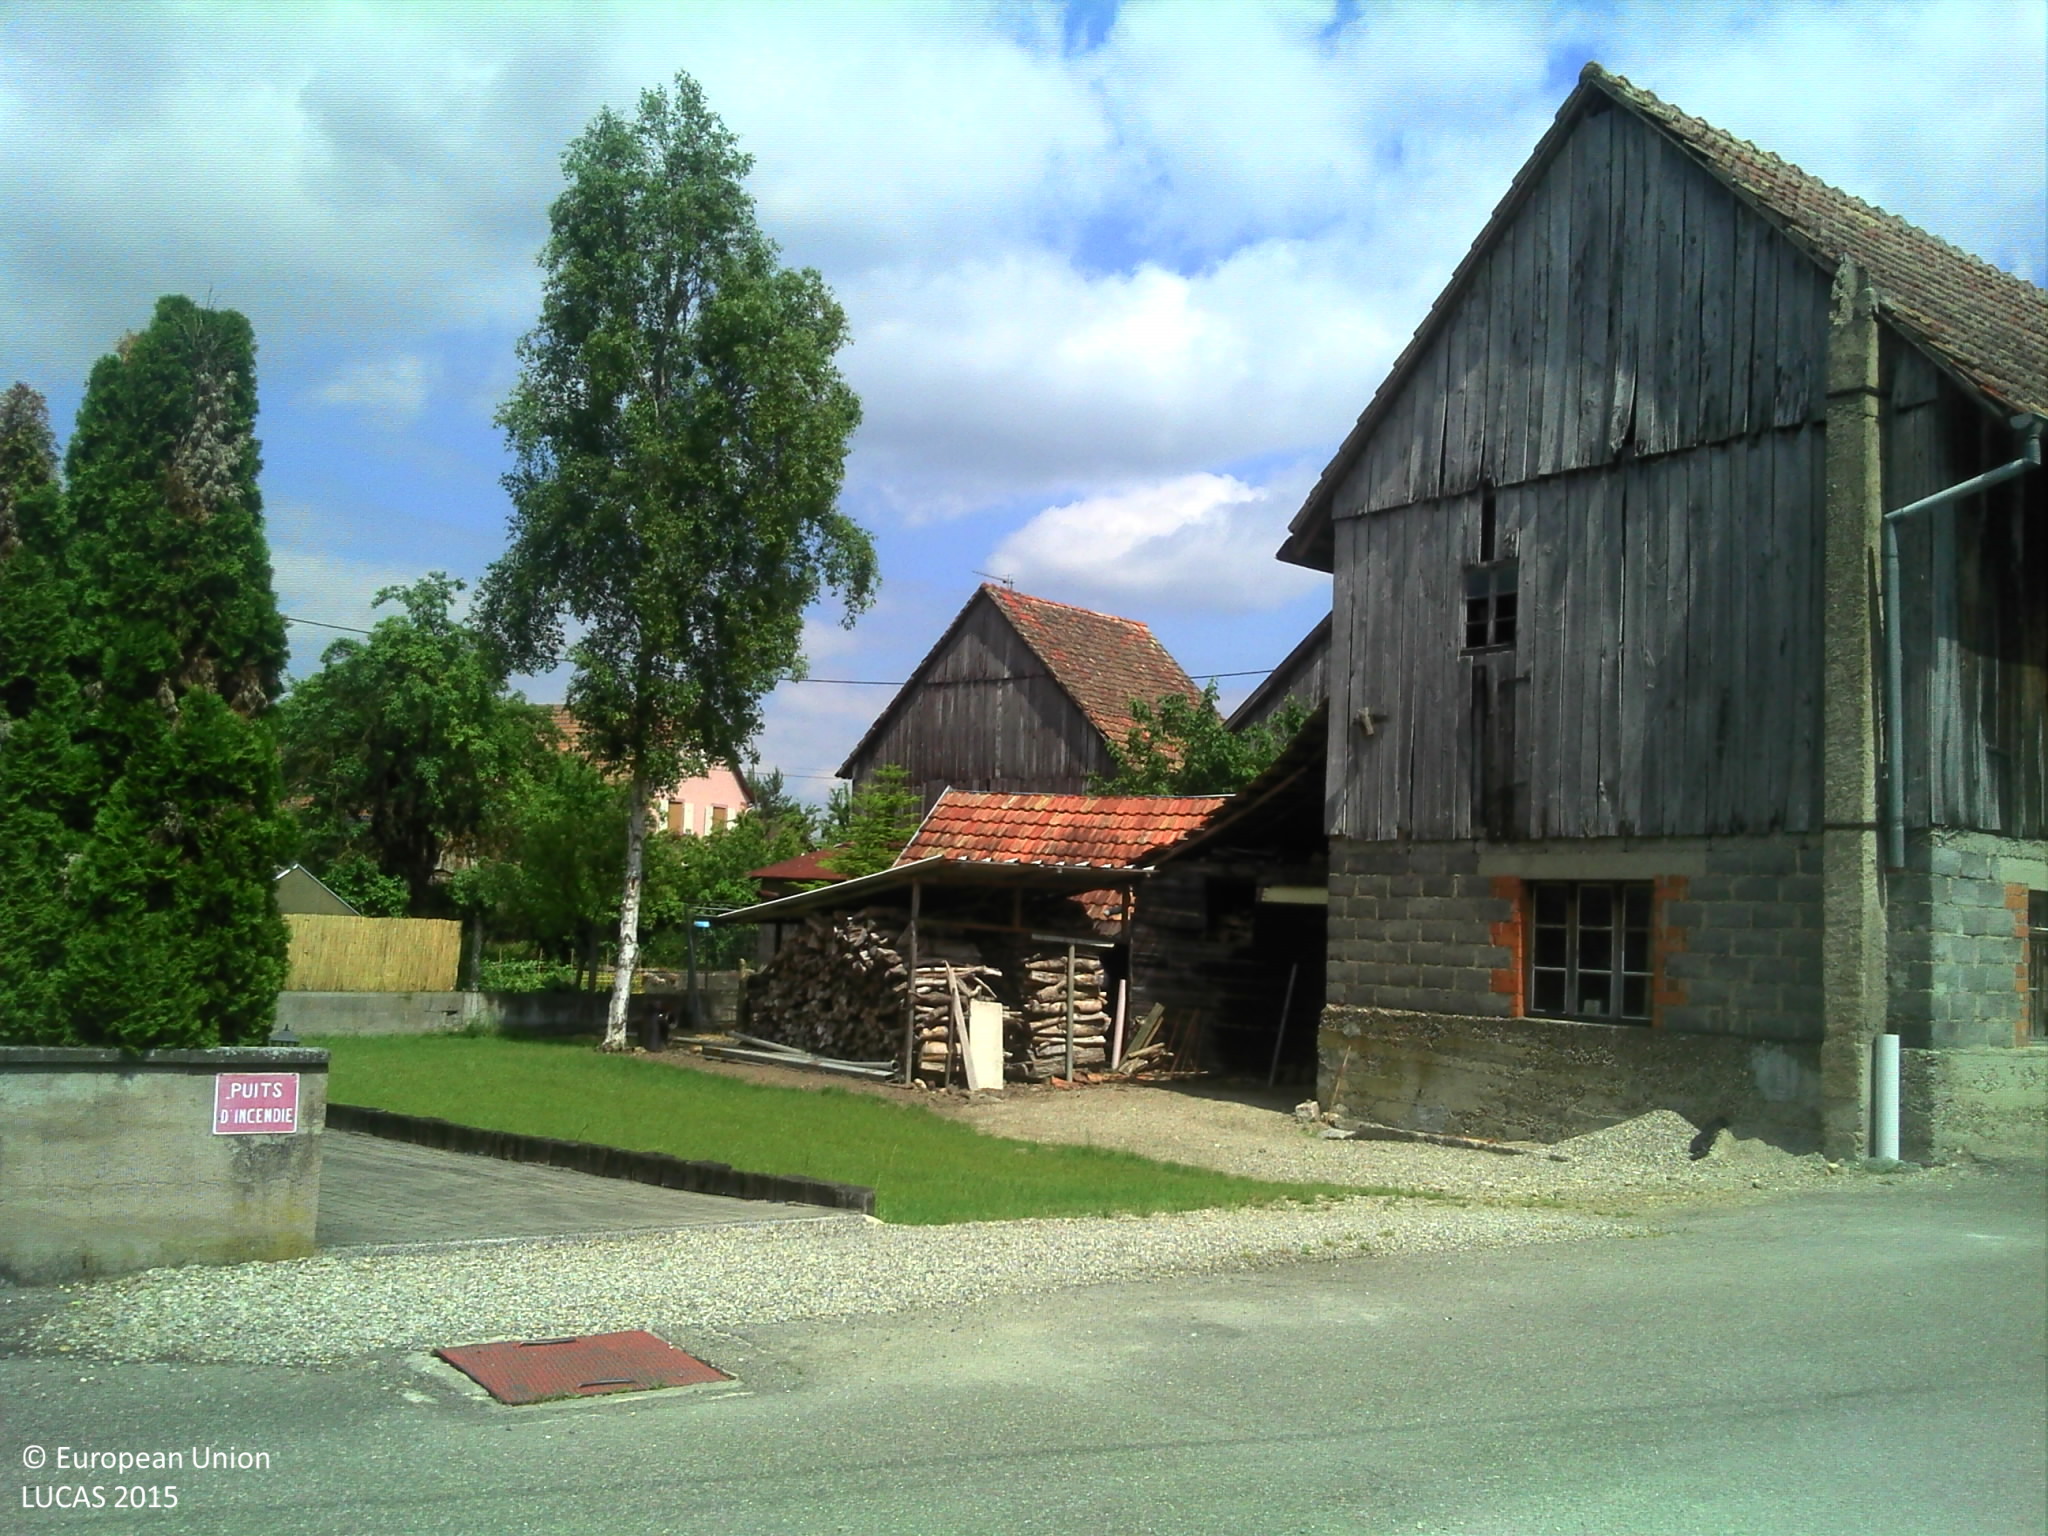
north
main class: Cropland
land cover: Other fresh vegetables
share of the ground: > 75 %
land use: Kitchen garden
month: May
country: FR
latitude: 48.2338
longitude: 7.6180
